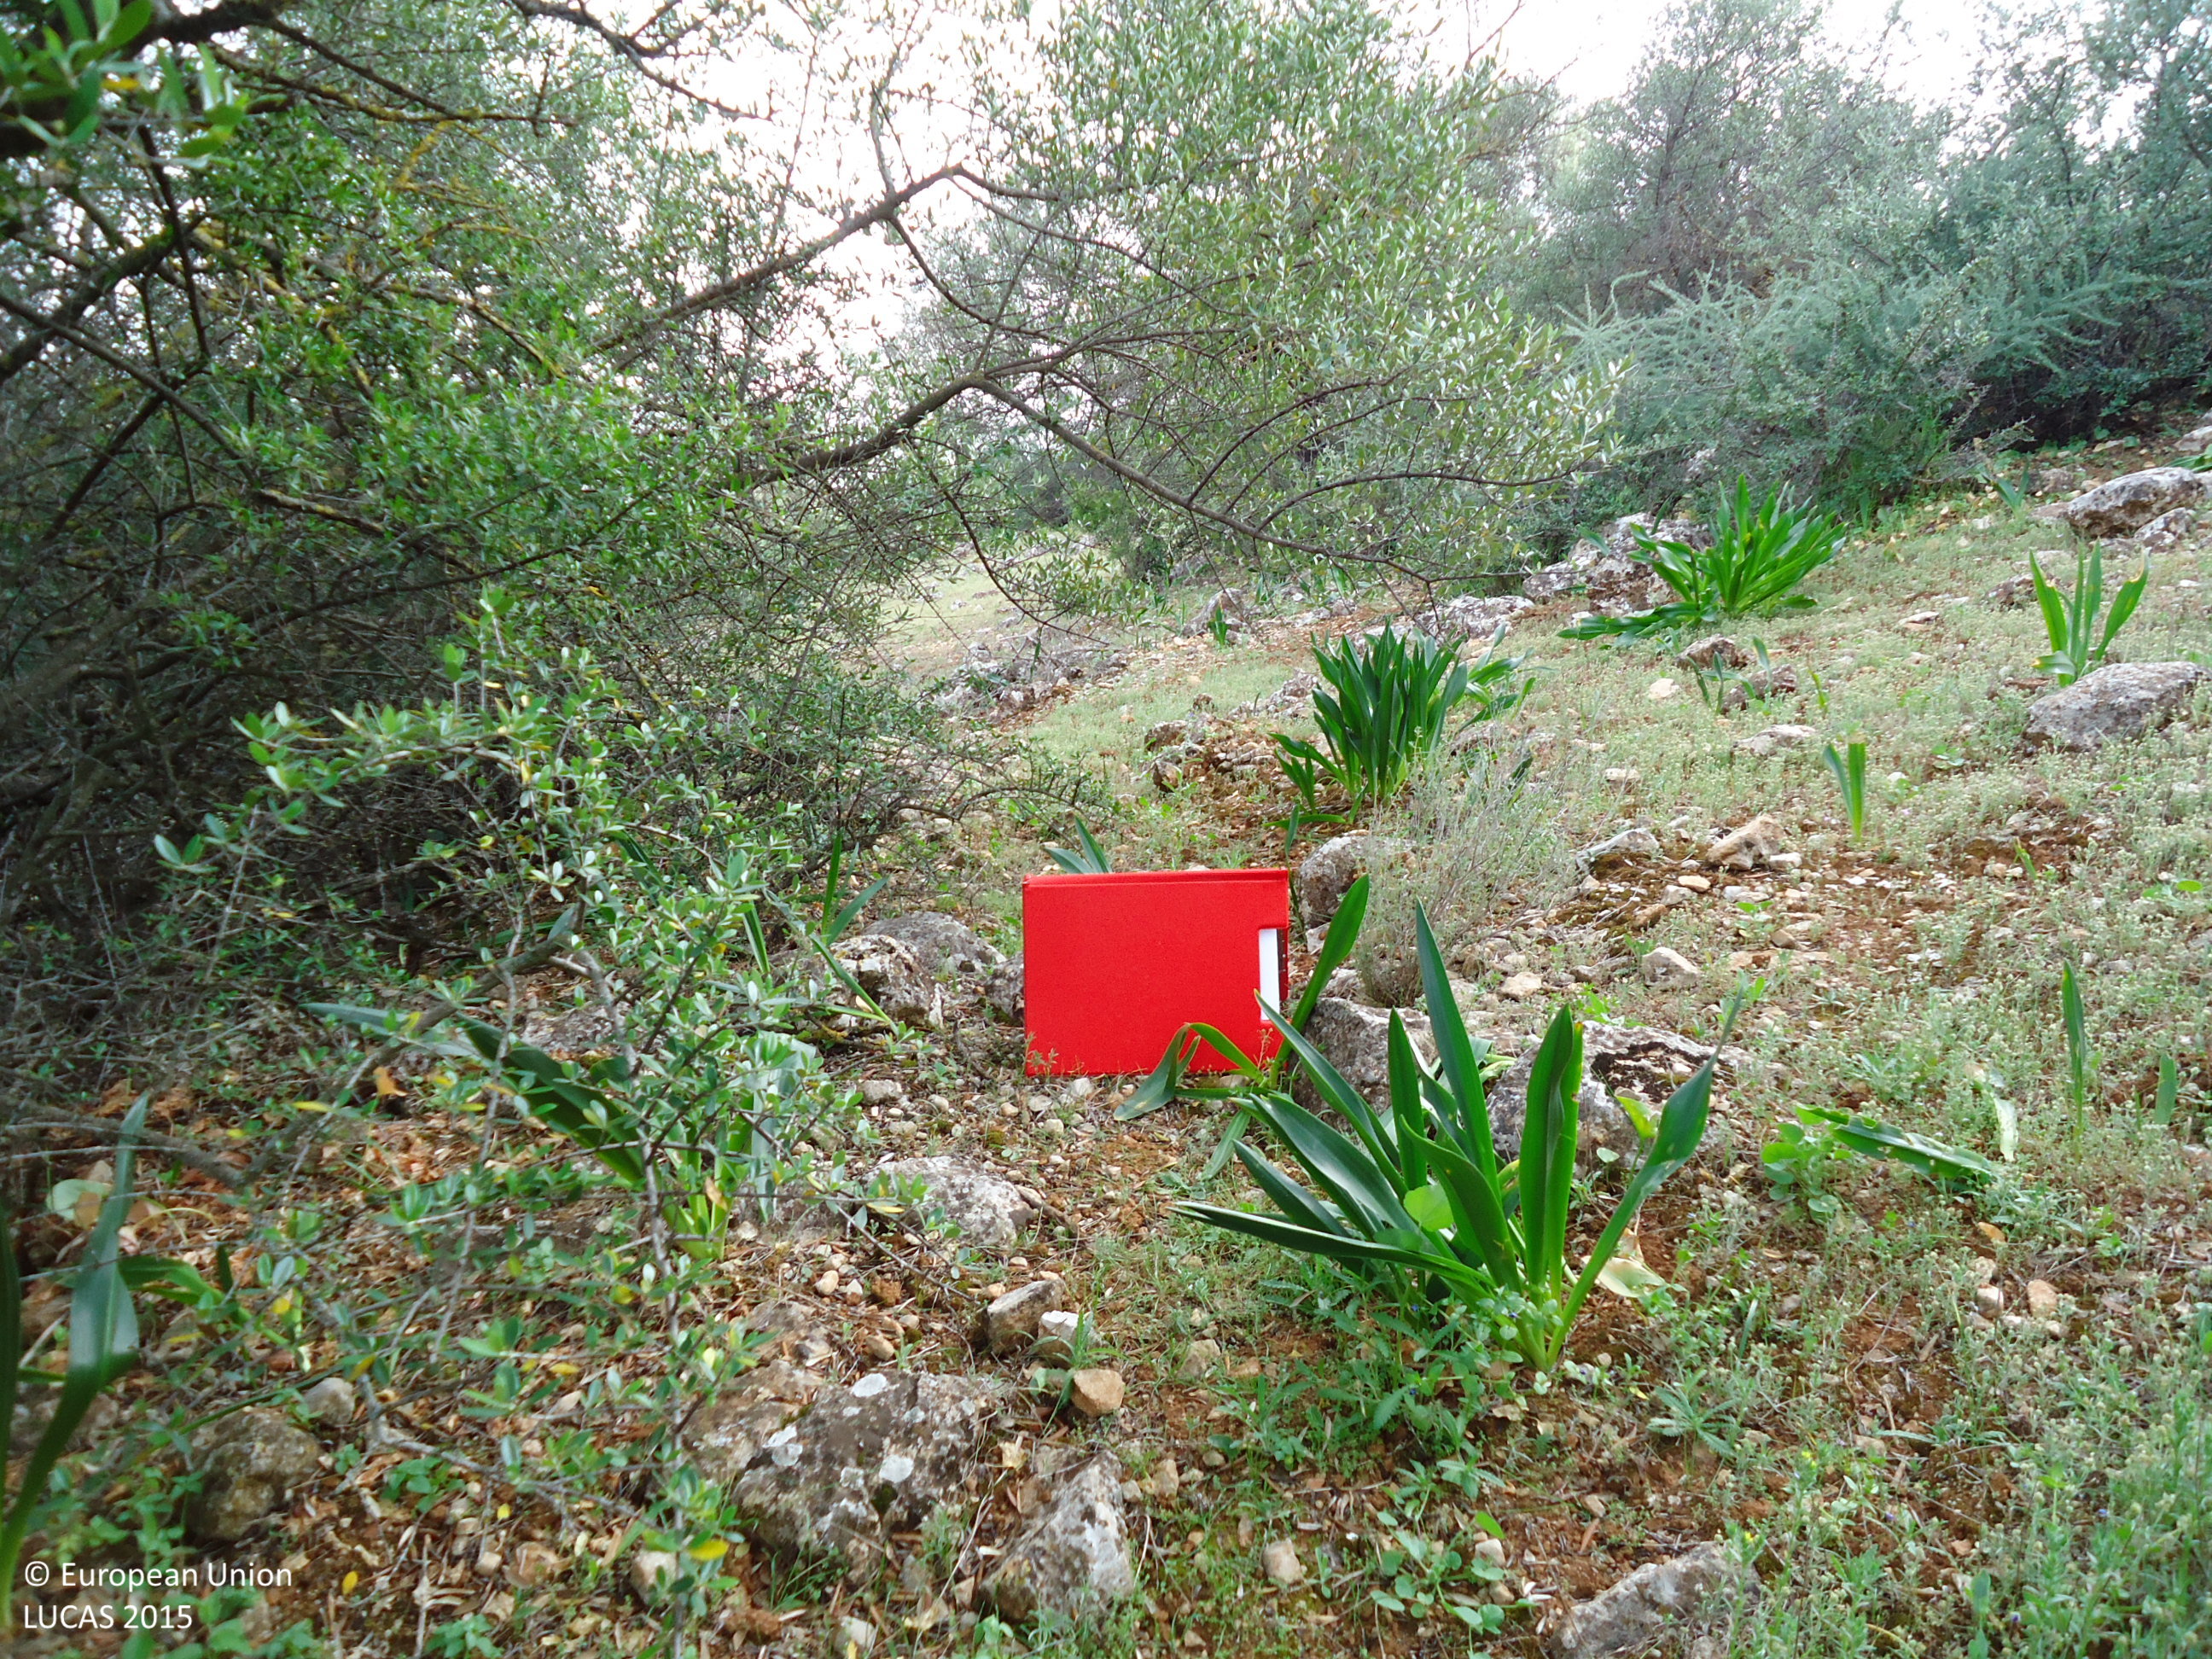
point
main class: Shrubland
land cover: Shrubland with sparse tree cover
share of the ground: 25 - 50 %
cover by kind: herbaceous plants 60 %, shrubs 35 %, broadleaved forest trees 5 %
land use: Semi-natural and natural areas not in use
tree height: < 5 m
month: April
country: ES
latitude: 37.1659
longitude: -4.8341
